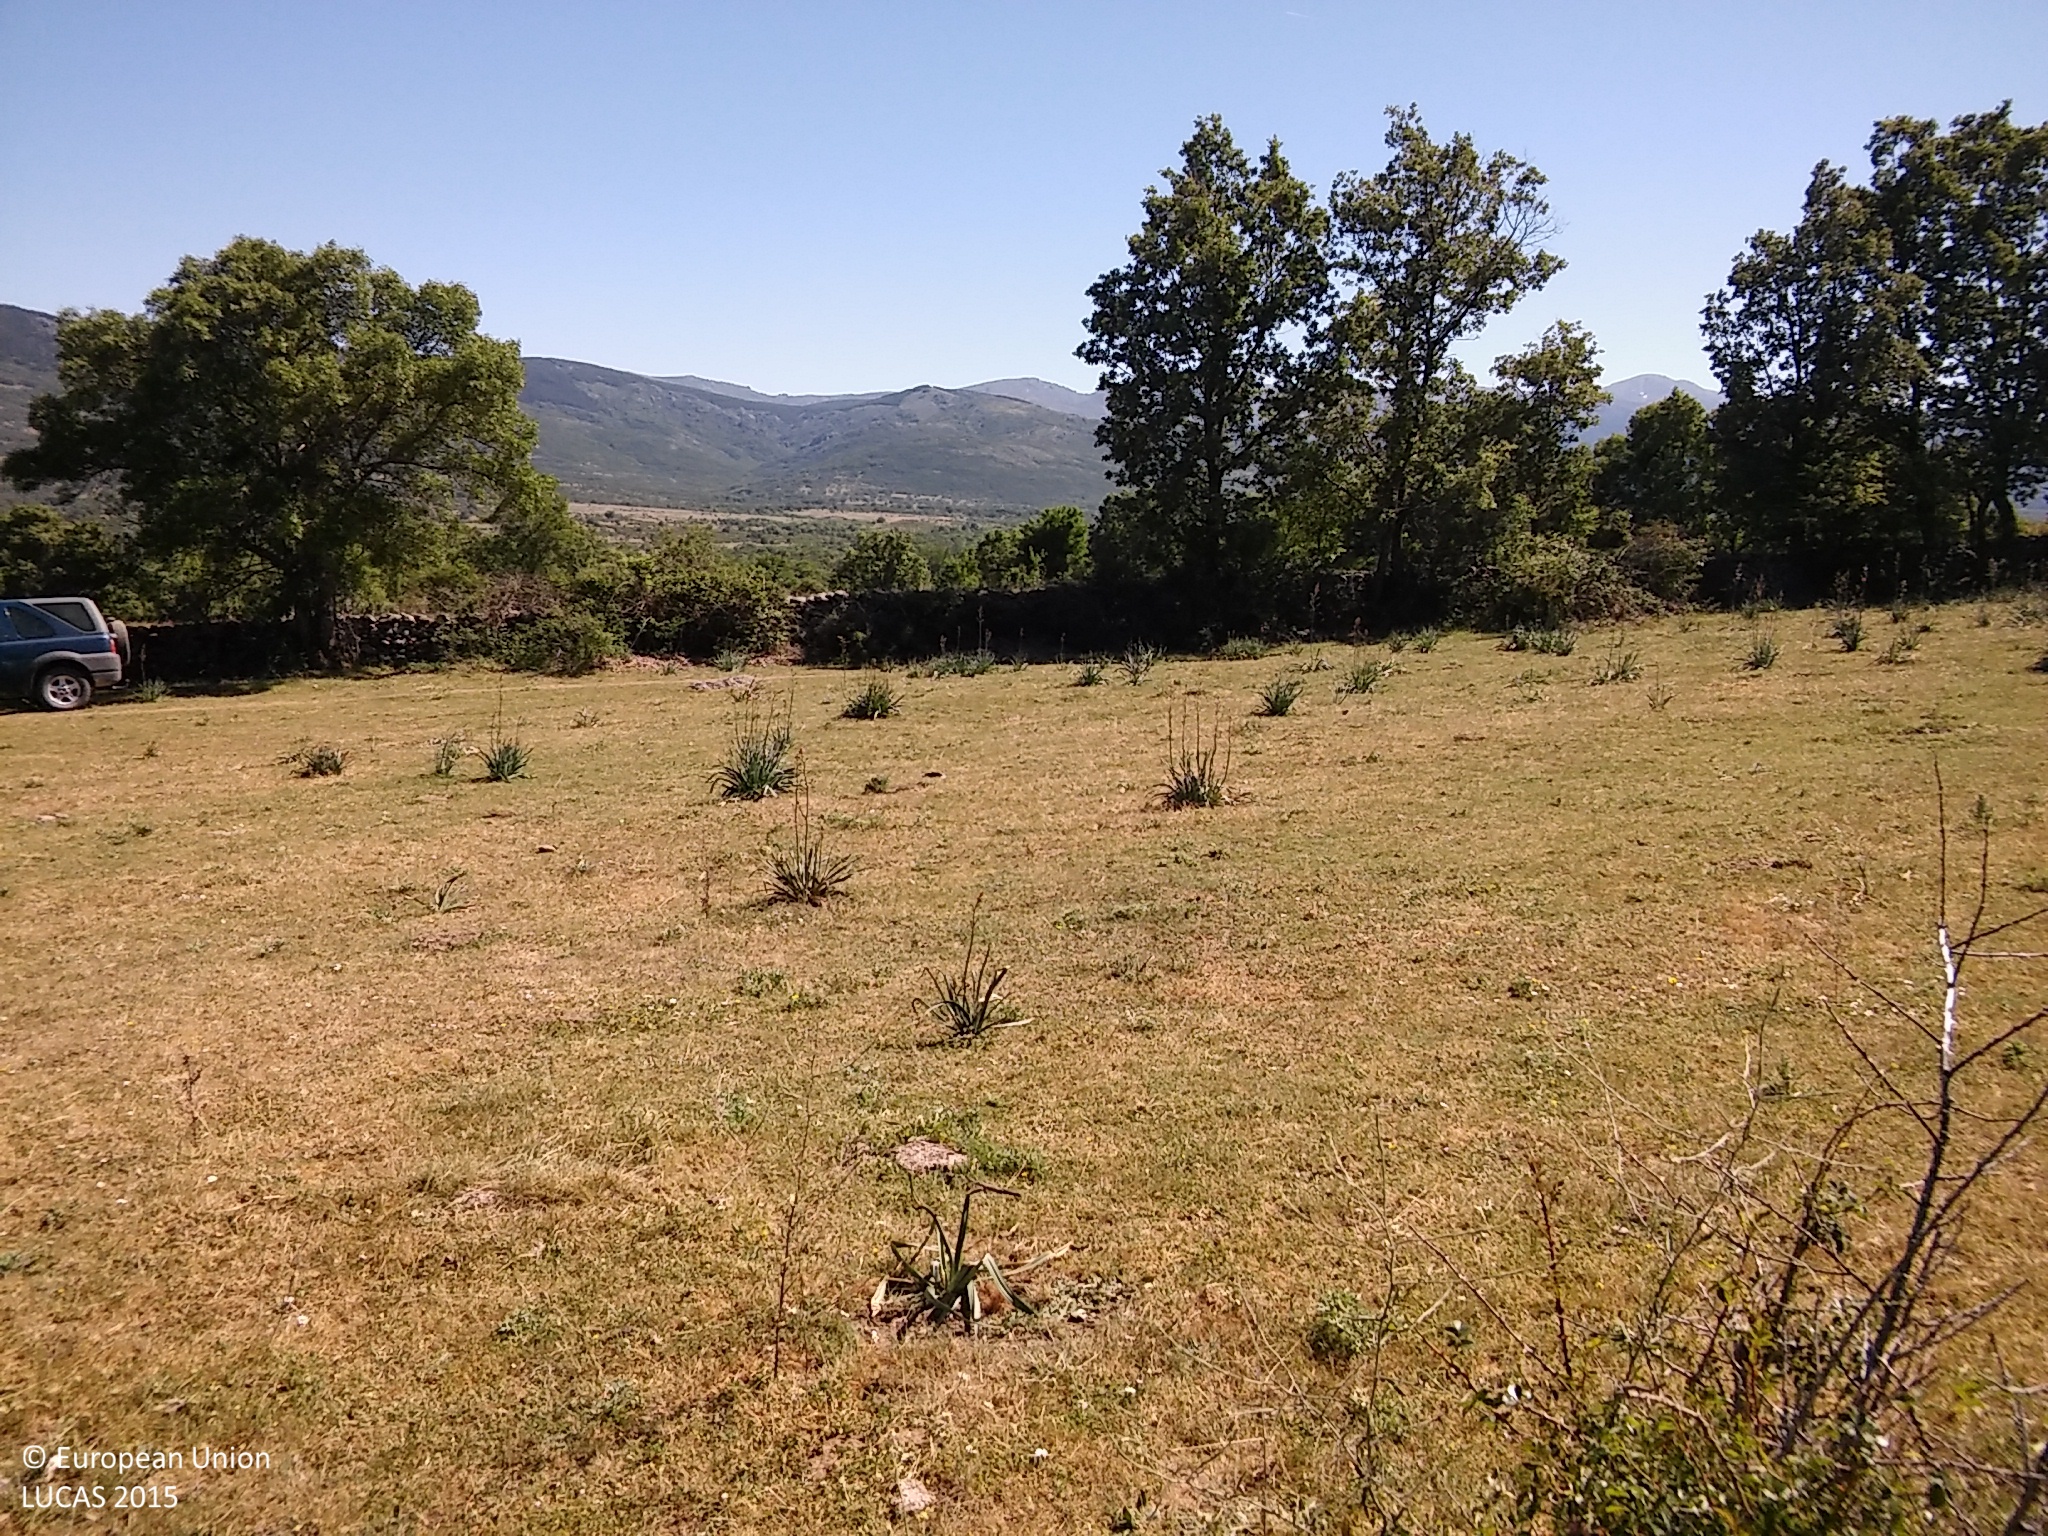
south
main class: Grassland
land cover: Grassland without tree/shrub cover
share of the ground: > 75 %
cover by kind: herbaceous plants 100 %
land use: Agriculture (excluding fallow land and kitchen gardens)
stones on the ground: < 10 %
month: May
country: ES
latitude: 40.9308
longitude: -3.8340
